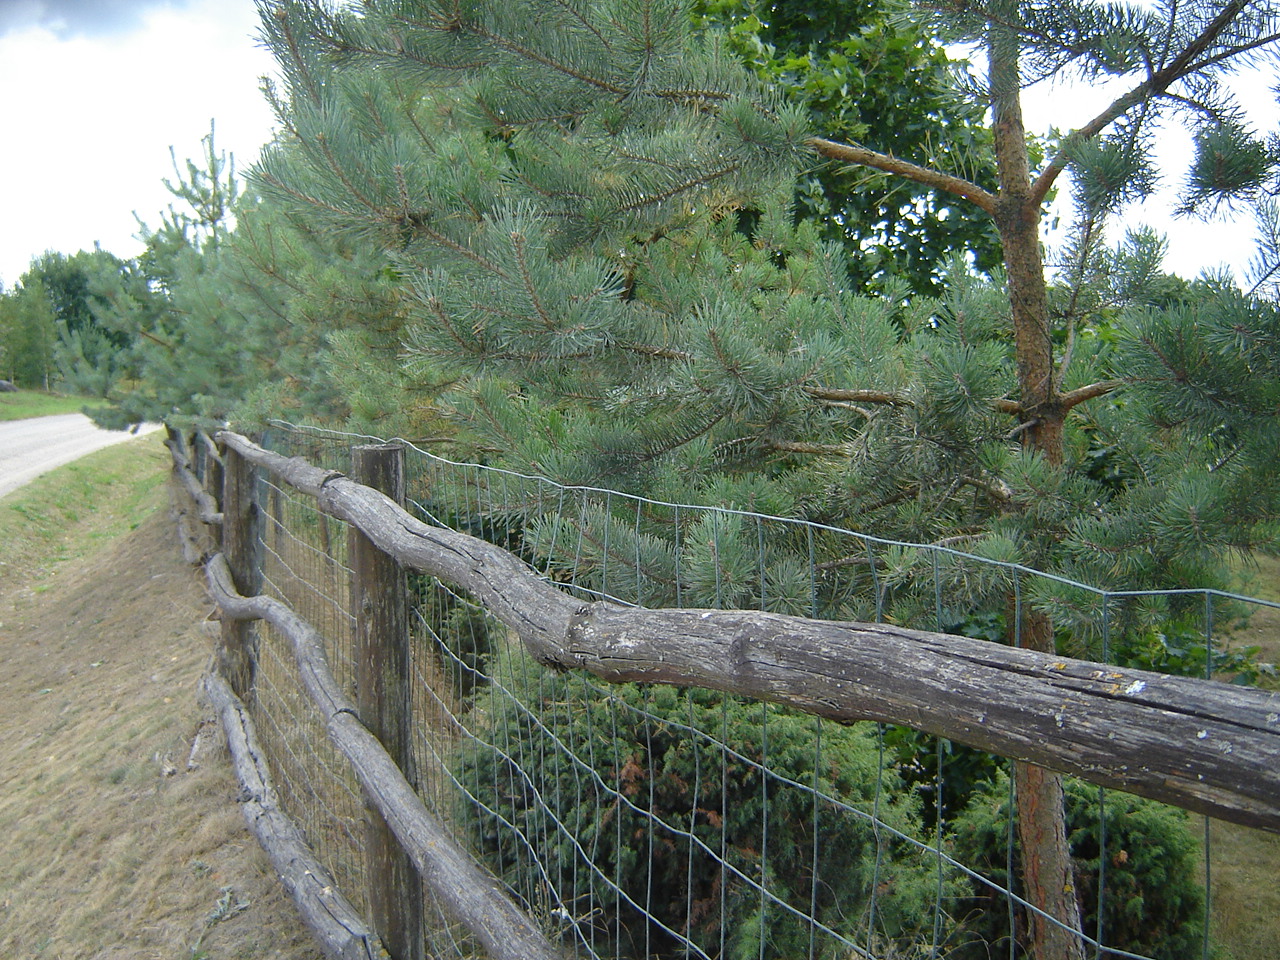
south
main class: Woodland
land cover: Pine dominated coniferous woodland
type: hemiboreal forest and nemoral coniferous forest and mixed broadleaved-coniferous forest
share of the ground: 50 - 75 %
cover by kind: coniferous forest trees 50 %, herbaceous plants 40 %, broadleaved forest trees 5 %, shrubs 5 %
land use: Residential
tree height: > 5 m
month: August
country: LT
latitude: 54.6191
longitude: 24.7114
